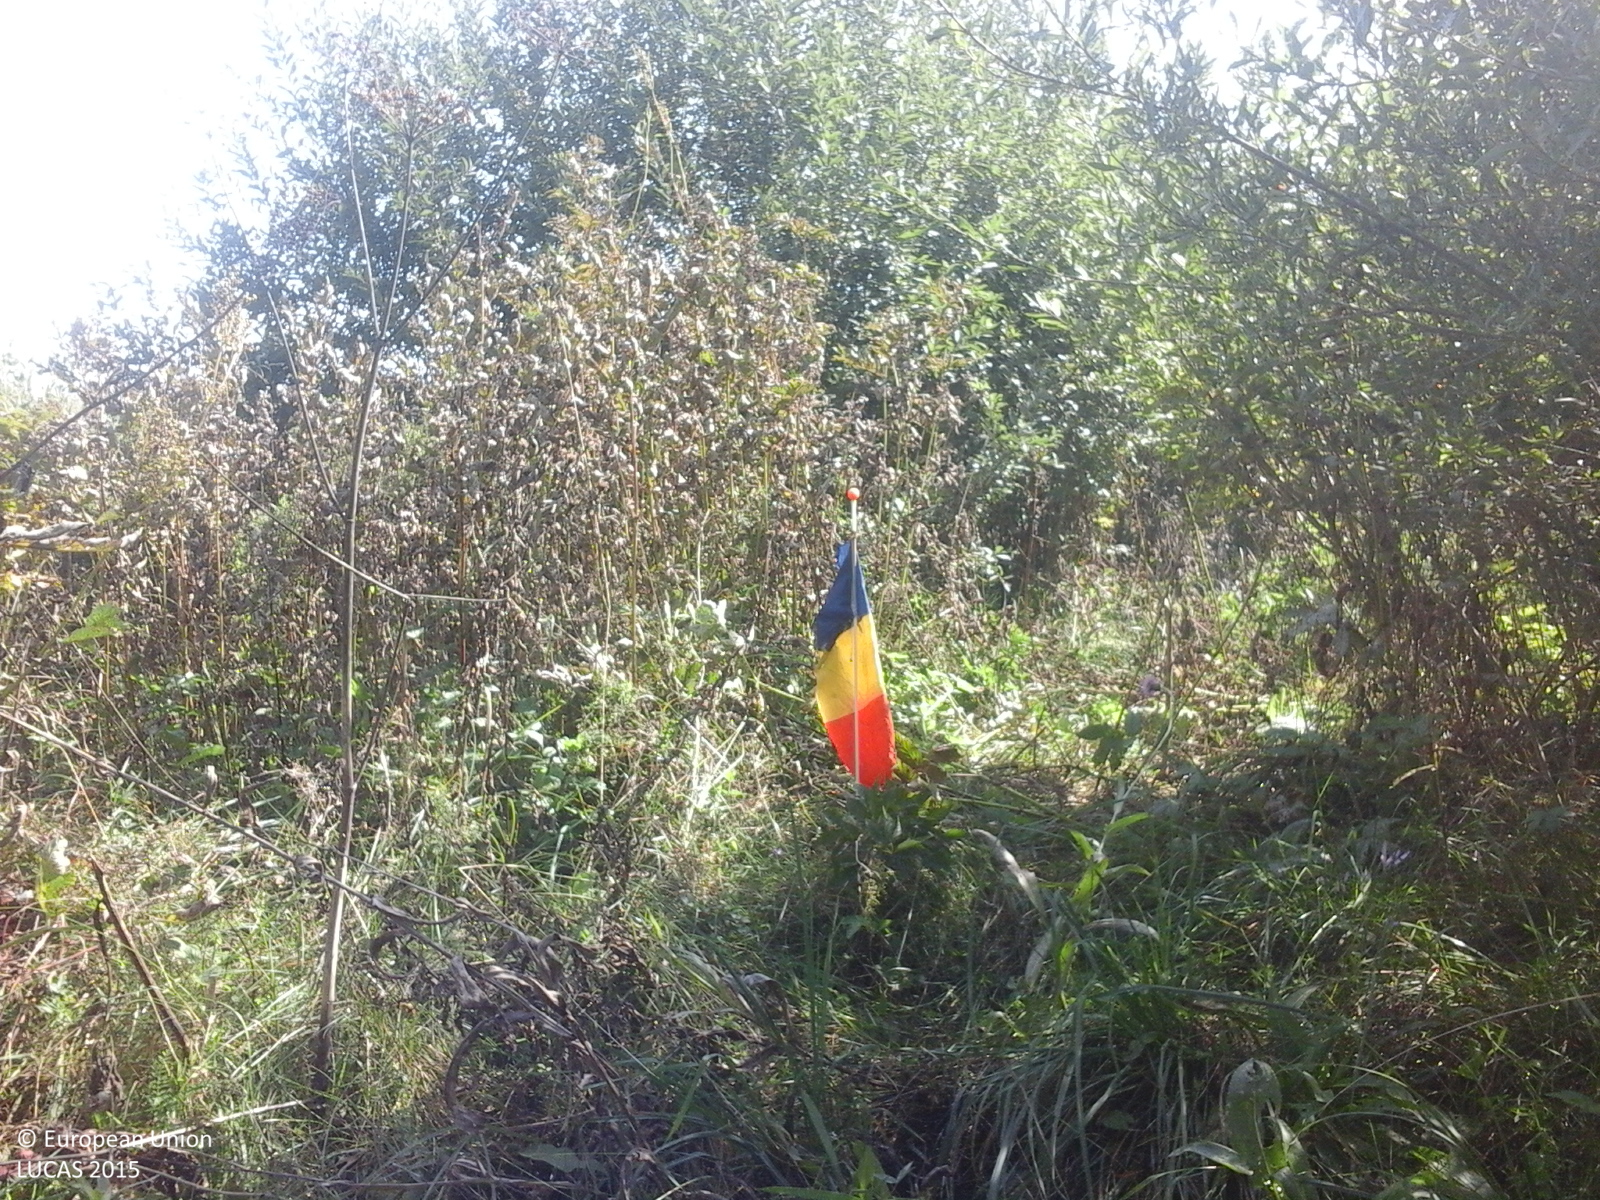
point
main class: Shrubland
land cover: Shrubland without tree cover
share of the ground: > 75 %
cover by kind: shrubs 100 %
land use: Fallow land
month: September
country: RO
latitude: 46.7644
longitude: 23.0906
